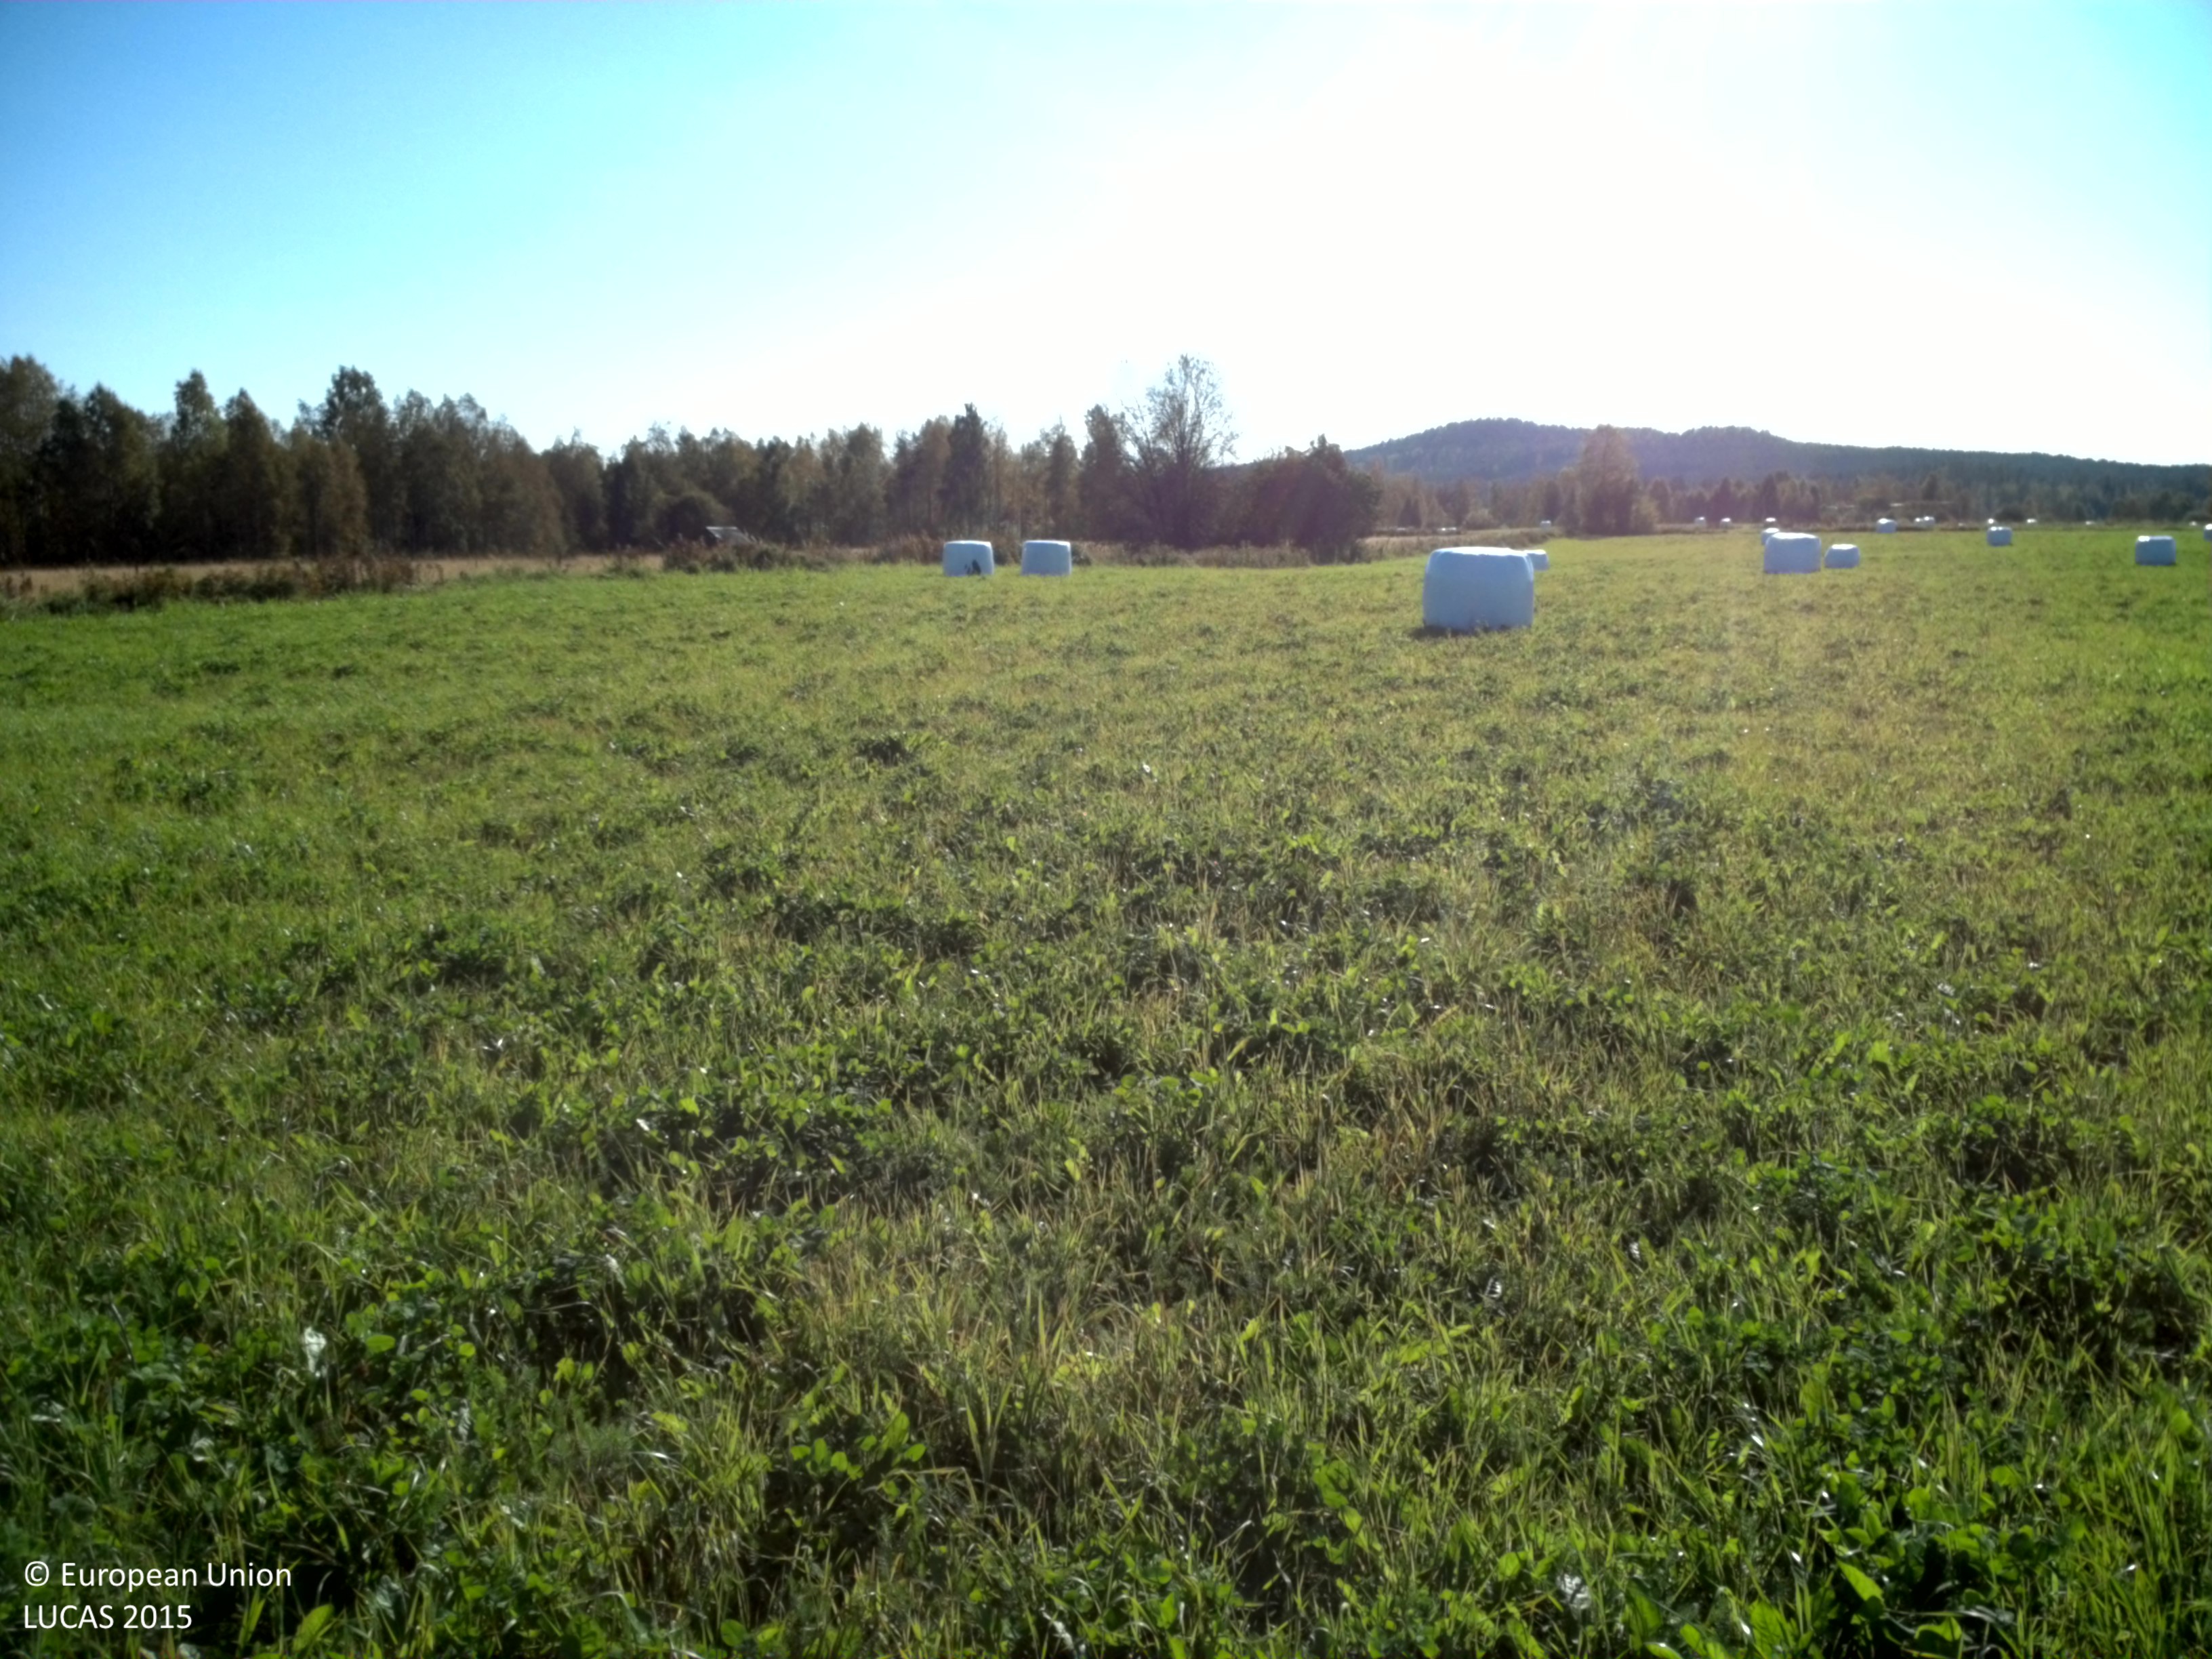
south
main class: Cropland
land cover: Temporary grasslands
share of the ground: > 75 %
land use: Agriculture (excluding fallow land and kitchen gardens)
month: September
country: SE
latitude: 65.9473
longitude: 22.1343
